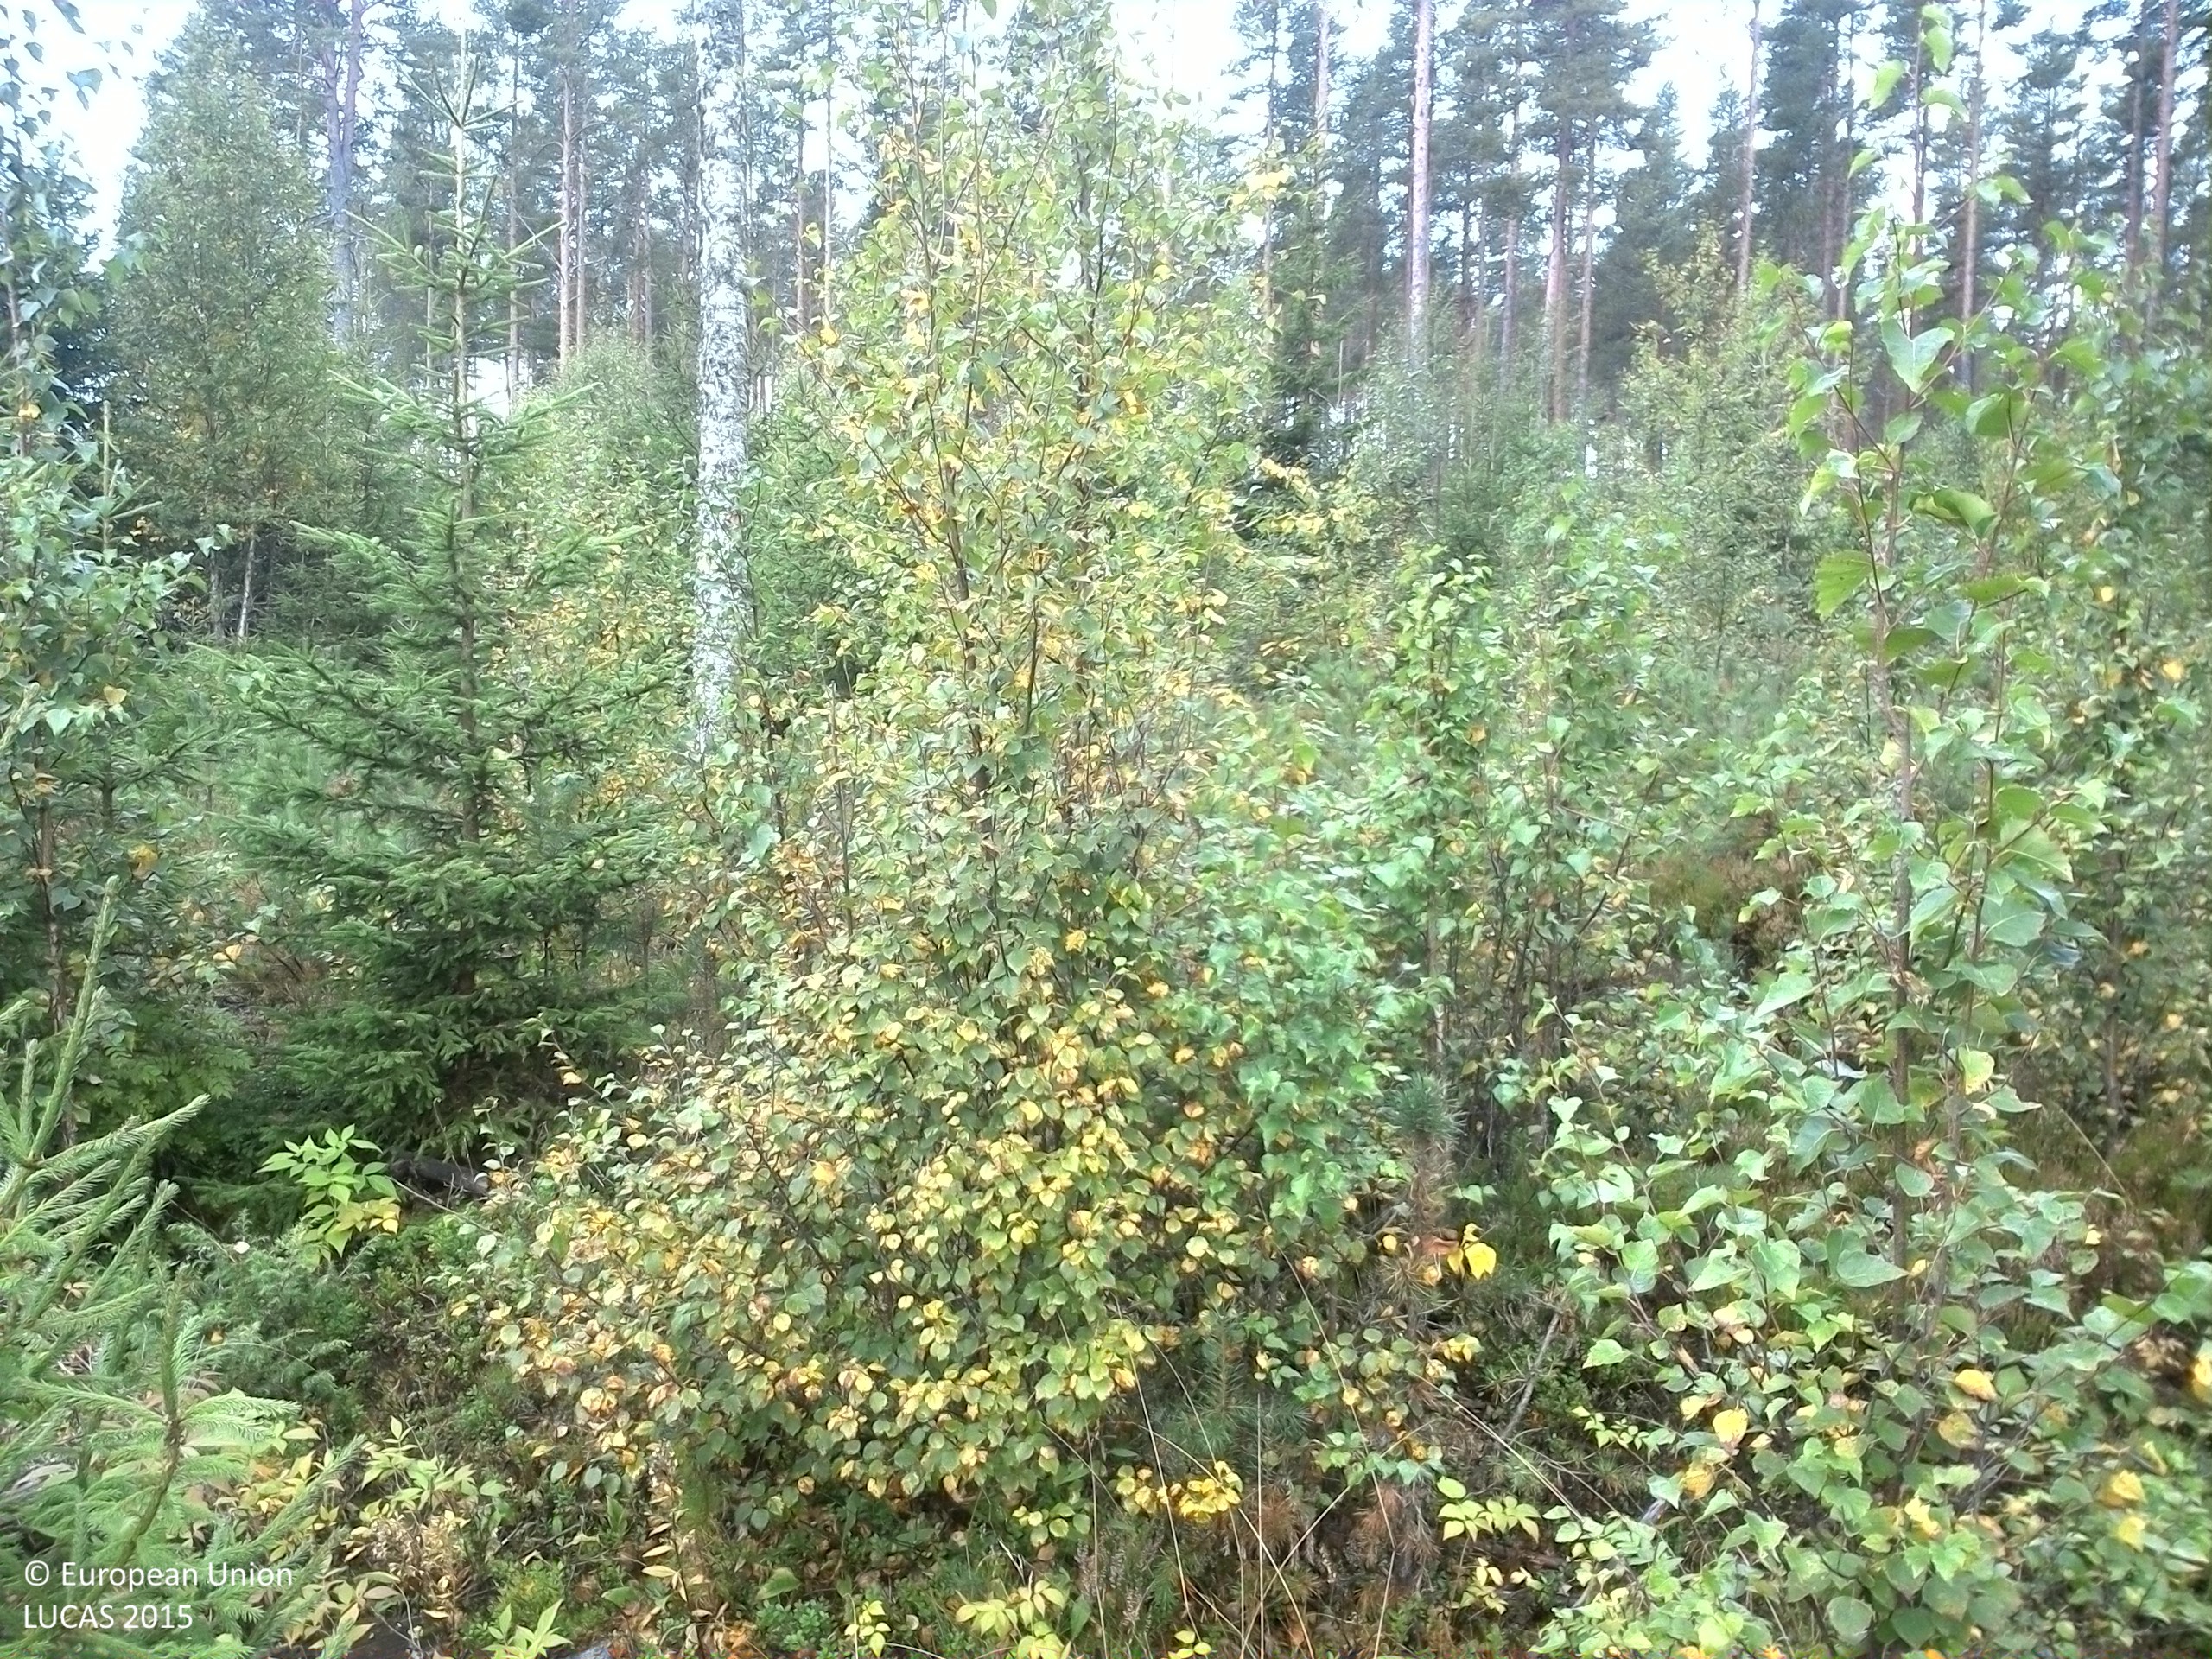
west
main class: Woodland
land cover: Other mixed woodland
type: boreal forest
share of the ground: 50 - 75 %
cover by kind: coniferous forest trees 30 %, broadleaved forest trees 30 %, shrubs 20 %, herbaceous plants 10 %, lichens and mosses 10 %
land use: Forestry
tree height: < 5 m
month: September
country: SE
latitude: 61.6383
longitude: 15.1730
